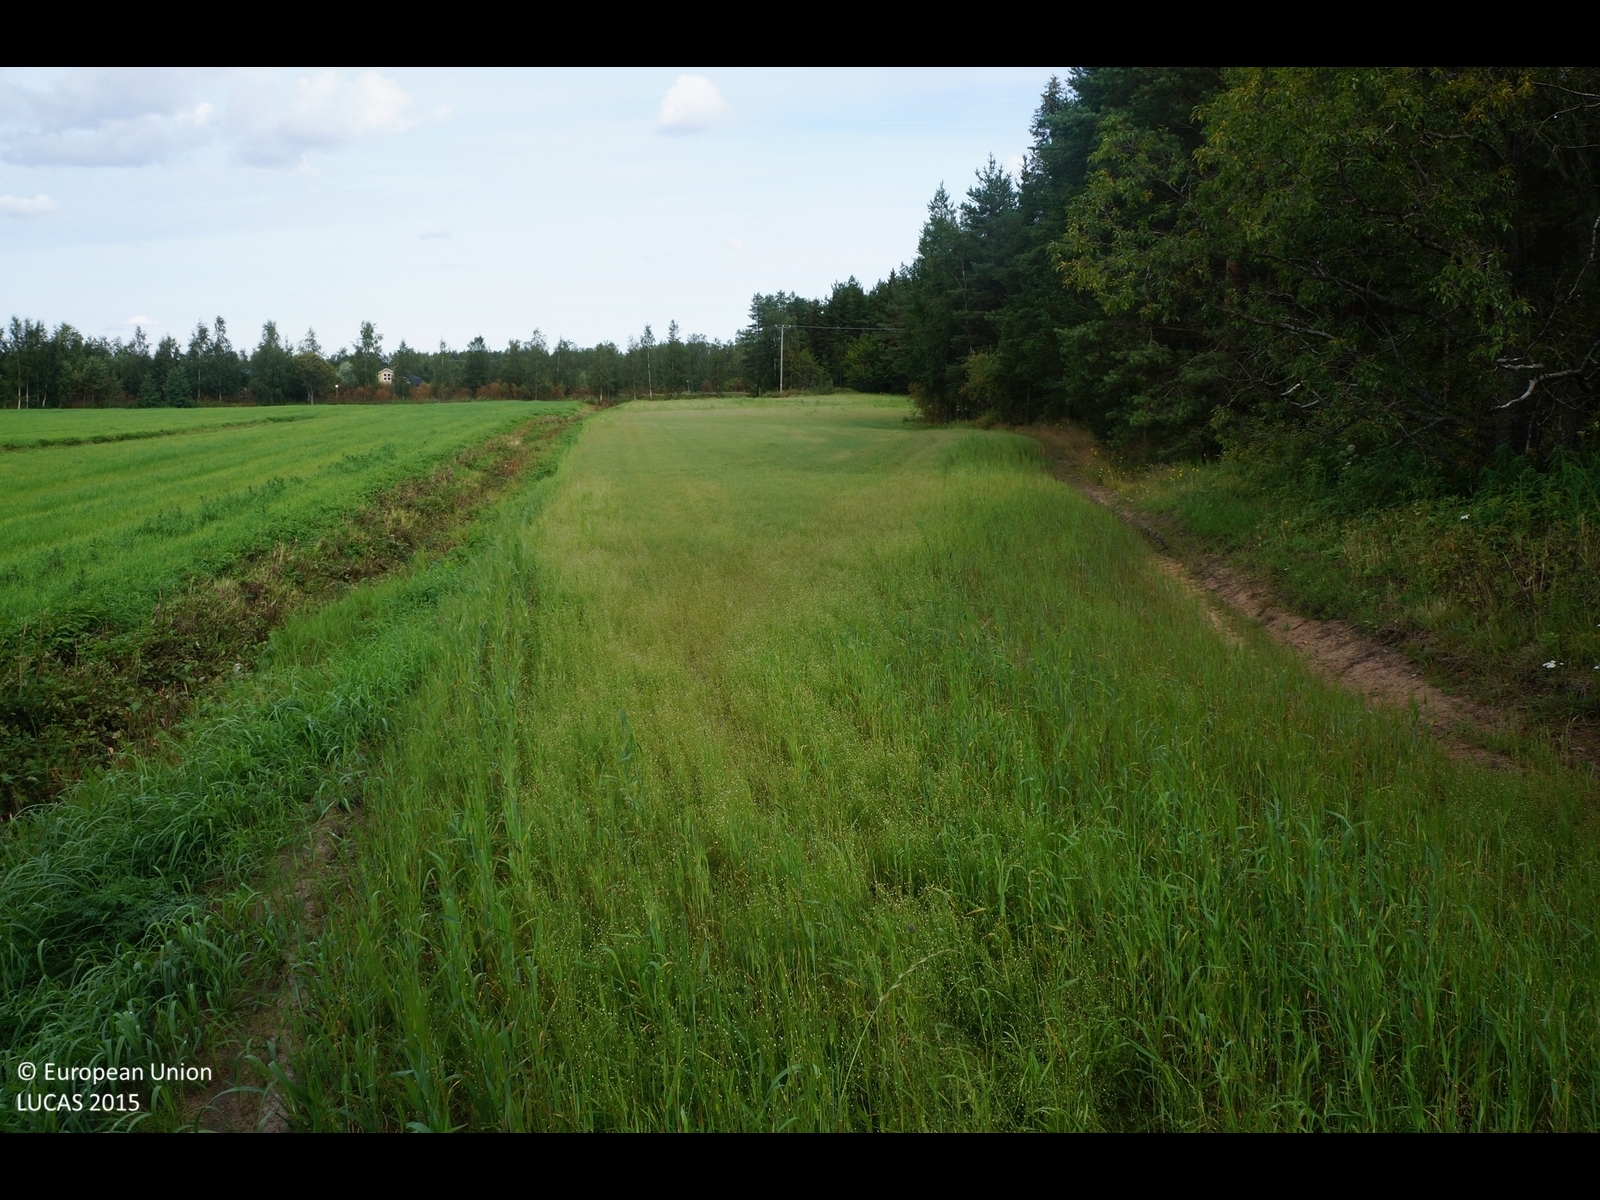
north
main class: Cropland
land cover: Temporary grasslands
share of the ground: > 75 %
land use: Agriculture (excluding fallow land and kitchen gardens)
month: August
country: FI
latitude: 64.8284
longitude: 24.7572
